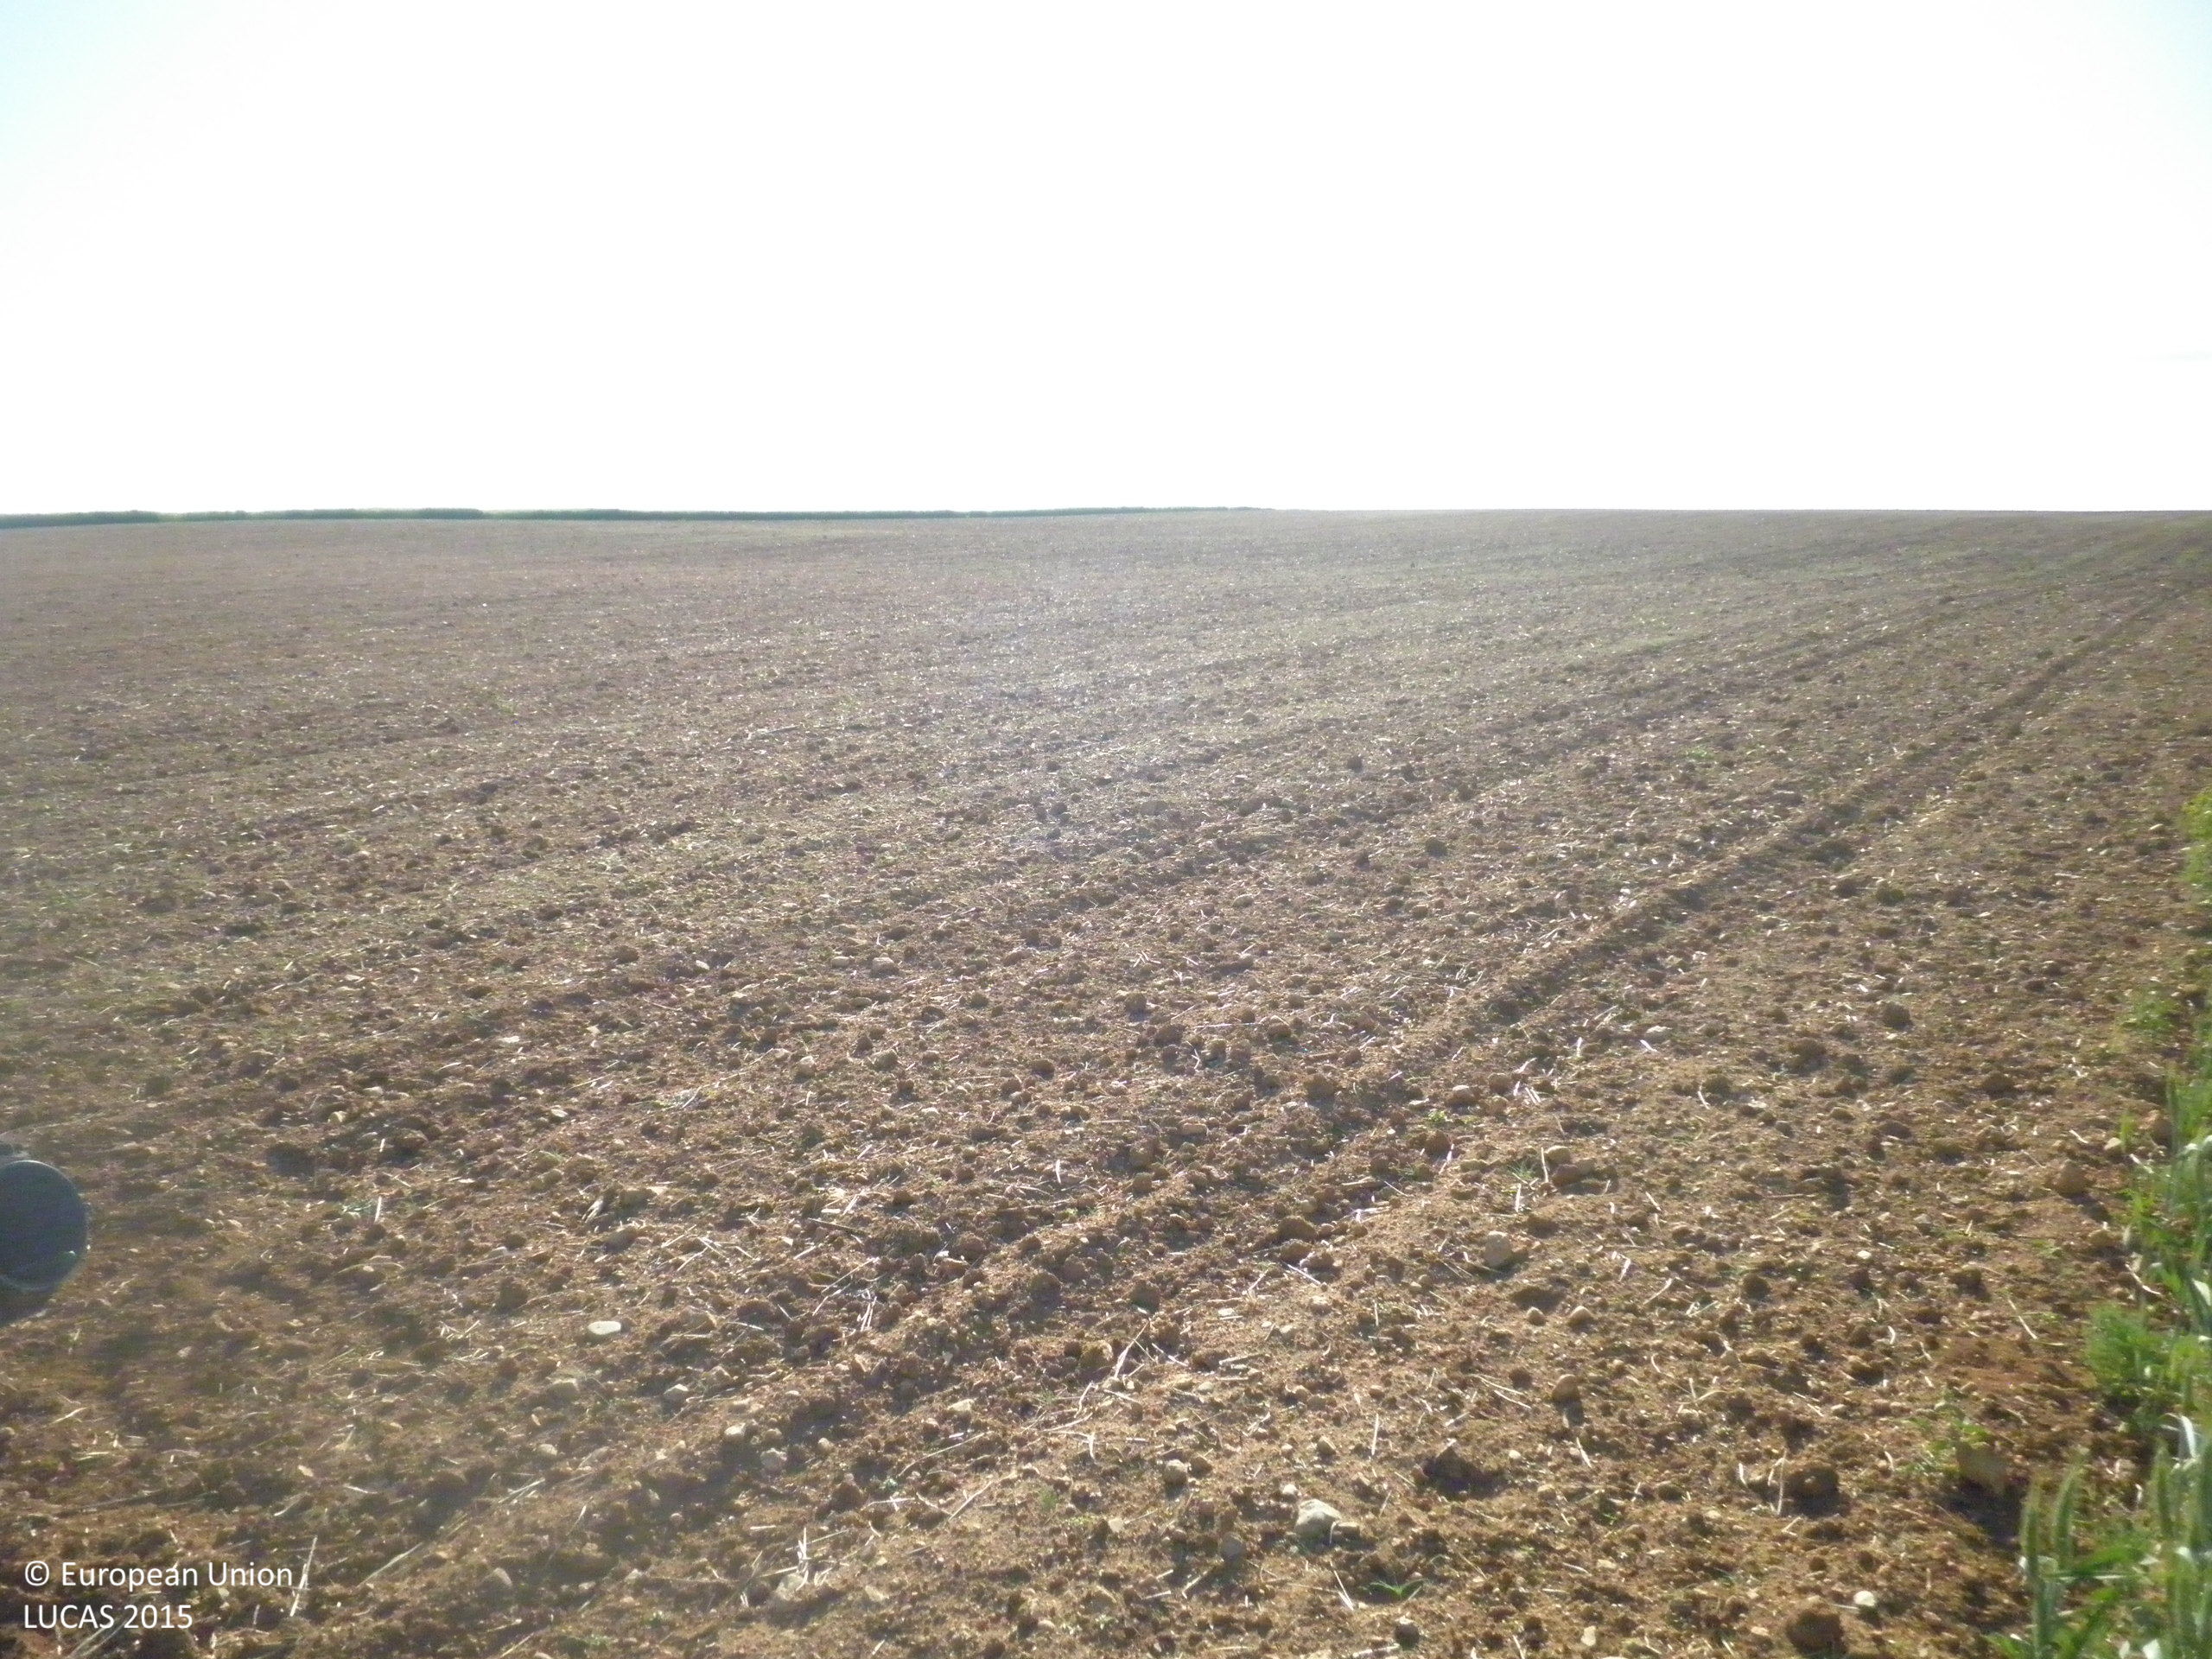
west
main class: Cropland
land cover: Rye
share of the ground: > 75 %
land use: Agriculture (excluding fallow land and kitchen gardens)
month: May
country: ES
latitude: 39.6864
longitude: -2.7616
